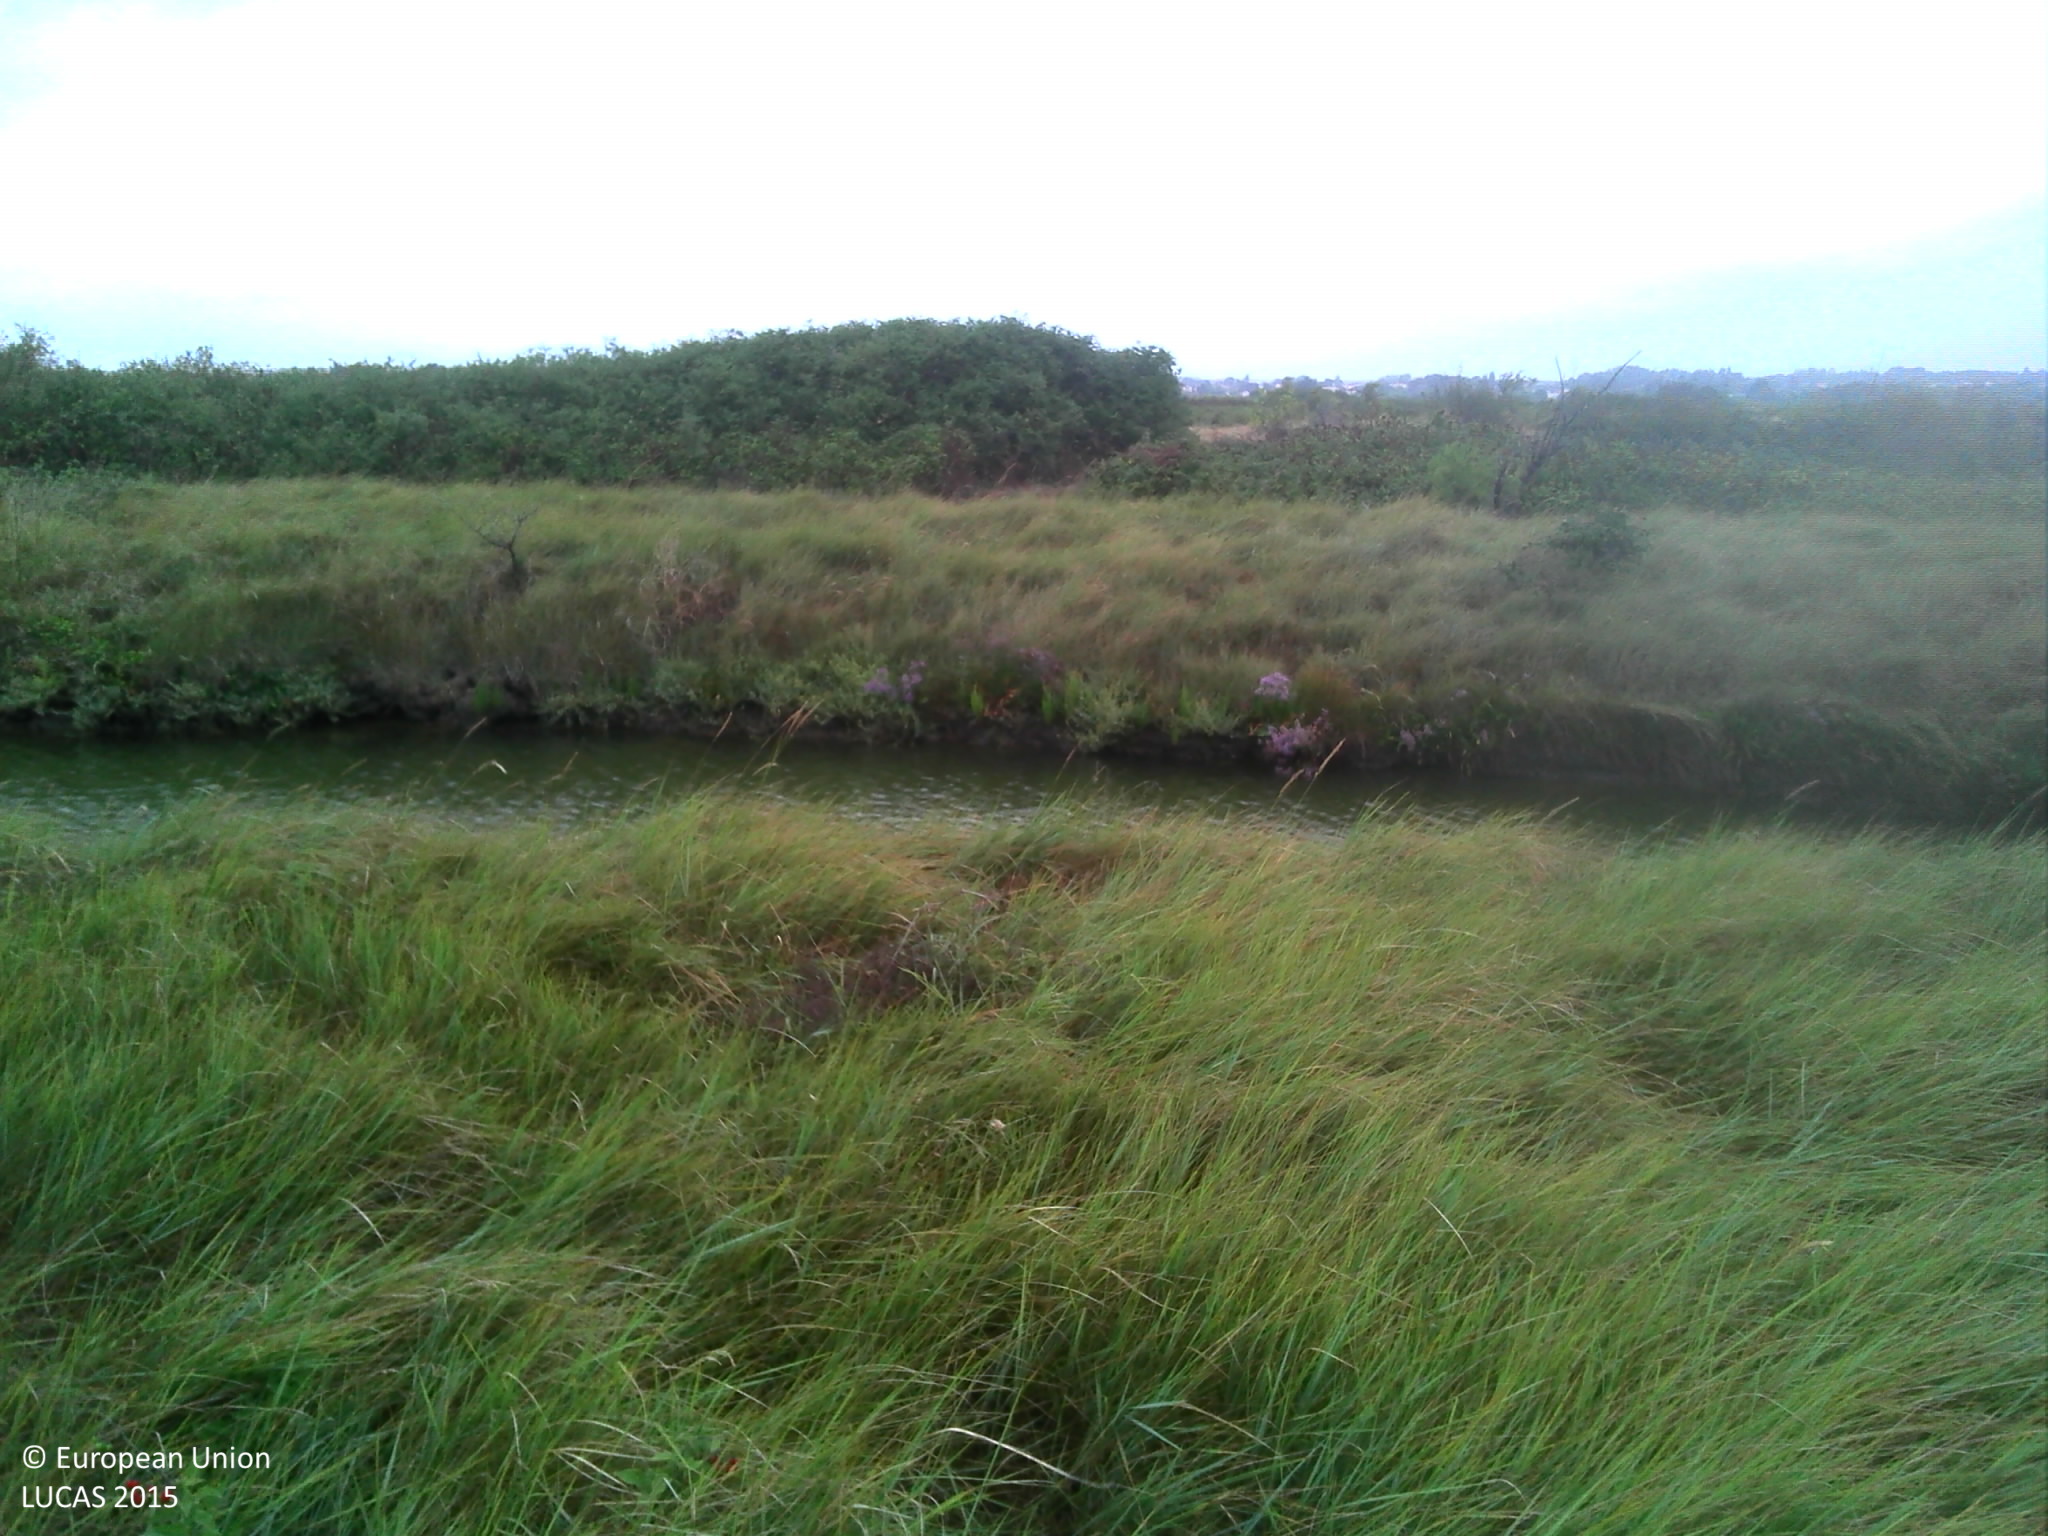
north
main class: Grassland
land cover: Spontaneously vegetated surfaces
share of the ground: > 75 %
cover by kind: herbaceous plants 95 %, shrubs 5 %
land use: Semi-natural and natural areas not in use
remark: Temporary flooded
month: August
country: FR
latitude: 46.5691
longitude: -1.7971
